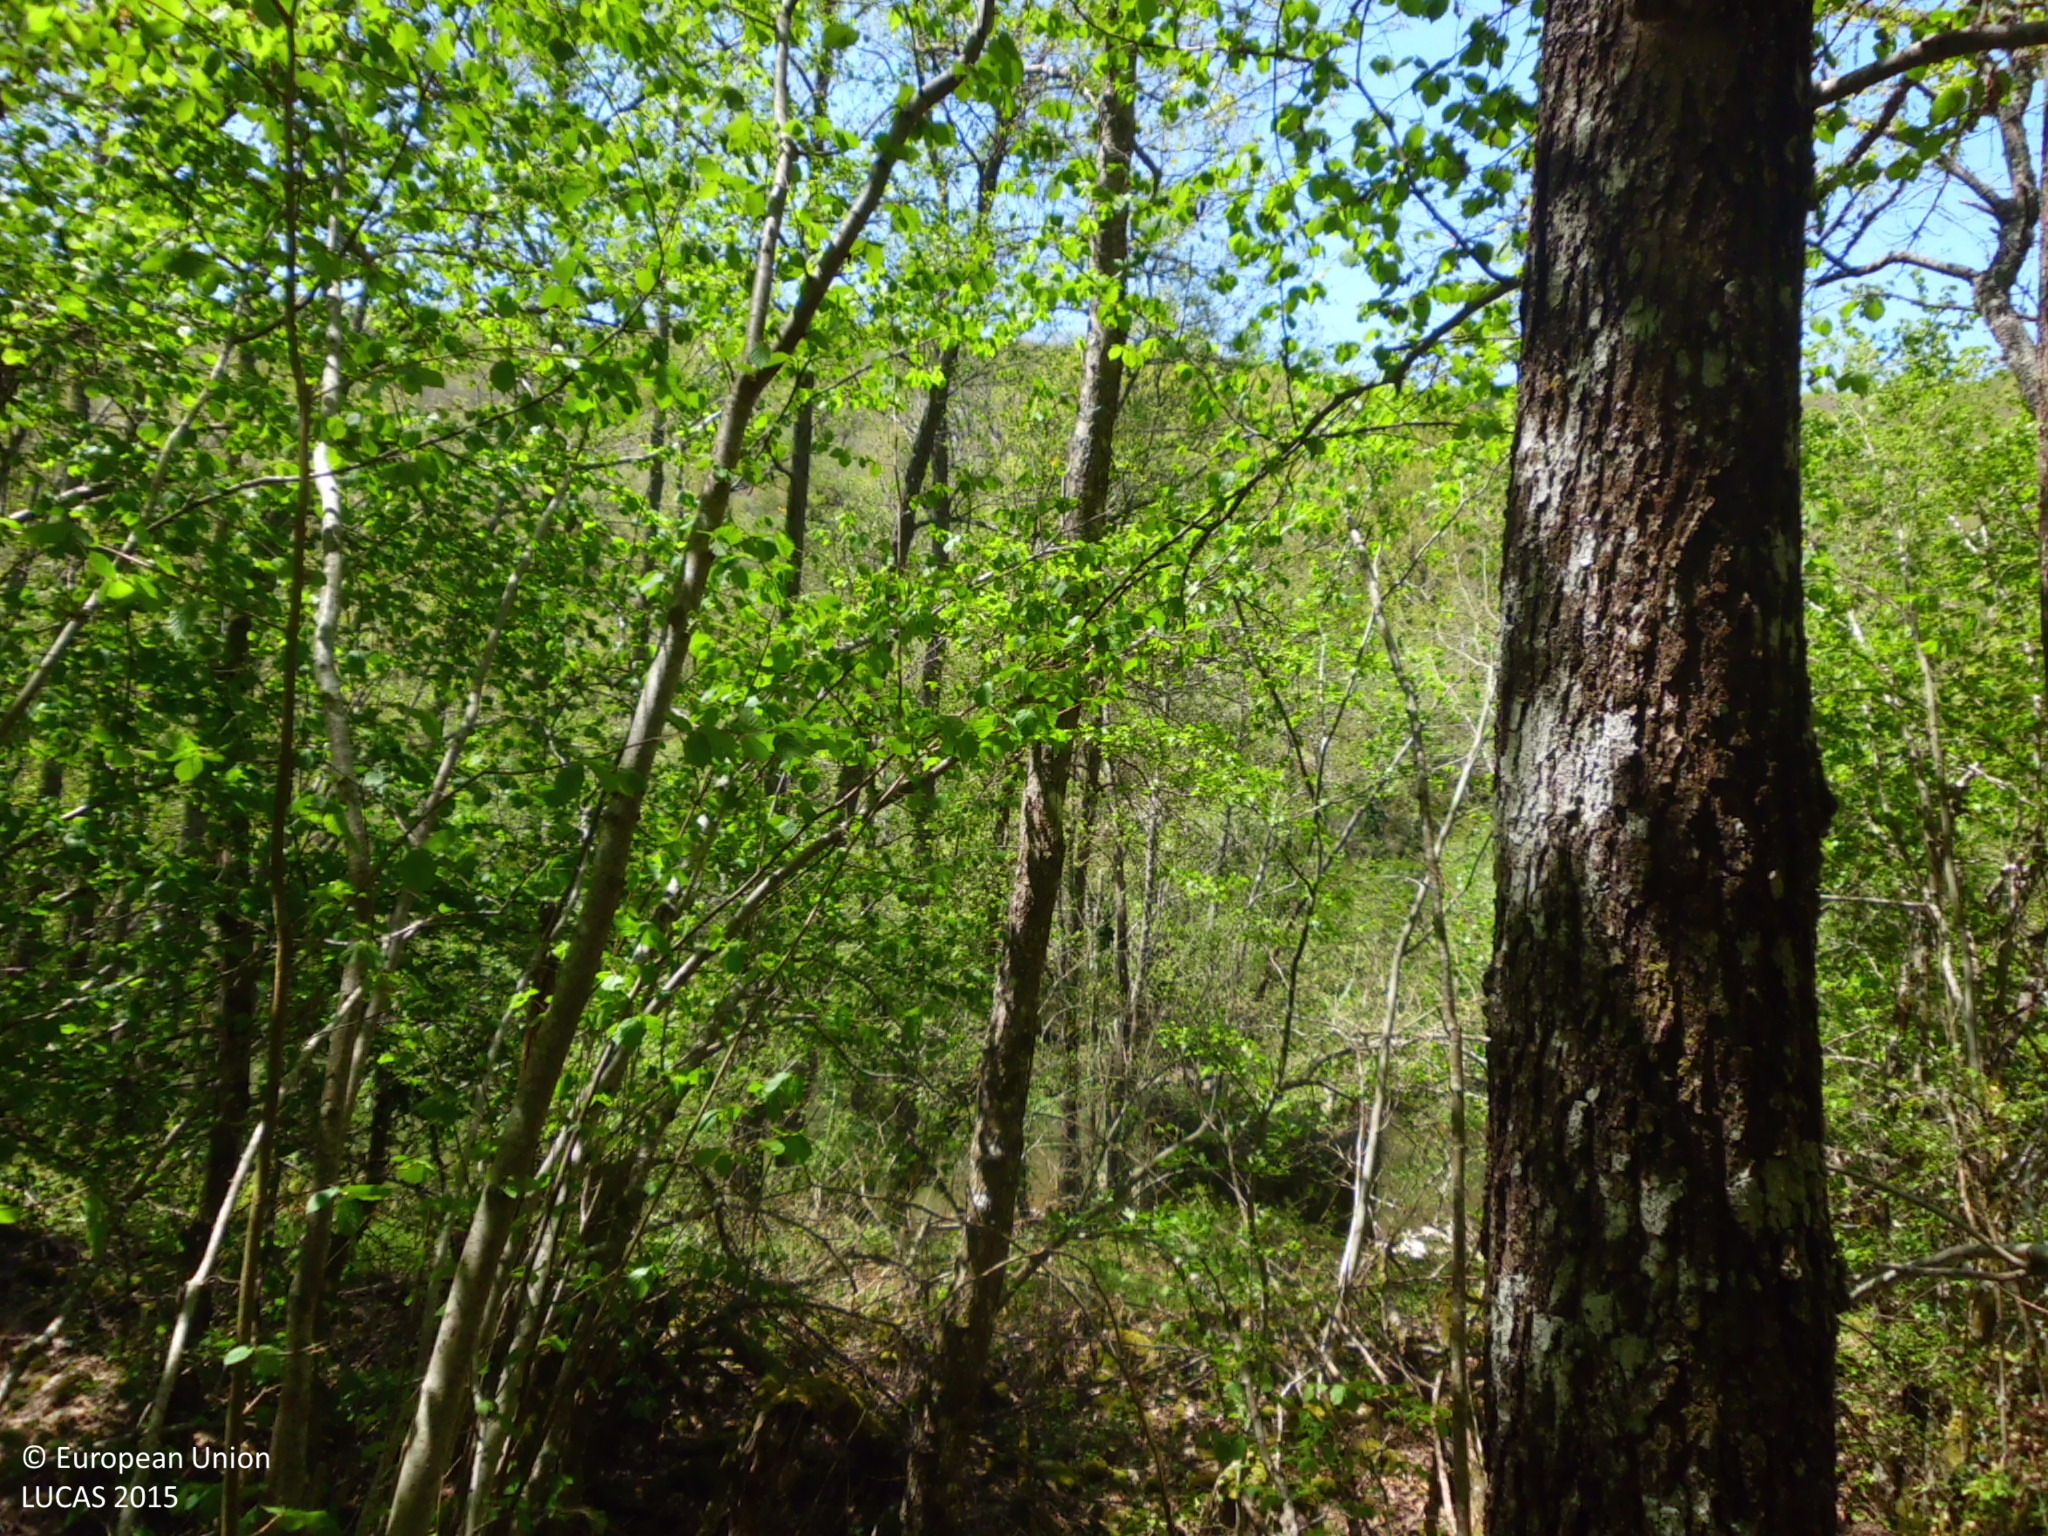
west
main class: Woodland
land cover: Broadleaved woodland
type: acidophilous oak and oak-birch forest
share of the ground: > 75 %
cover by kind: broadleaved forest trees 90 %, shrubs 5 %, herbaceous plants 5 %
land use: Semi-natural and natural areas not in use
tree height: > 5 m
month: May
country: ES
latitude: 42.9171
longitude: -4.0249
